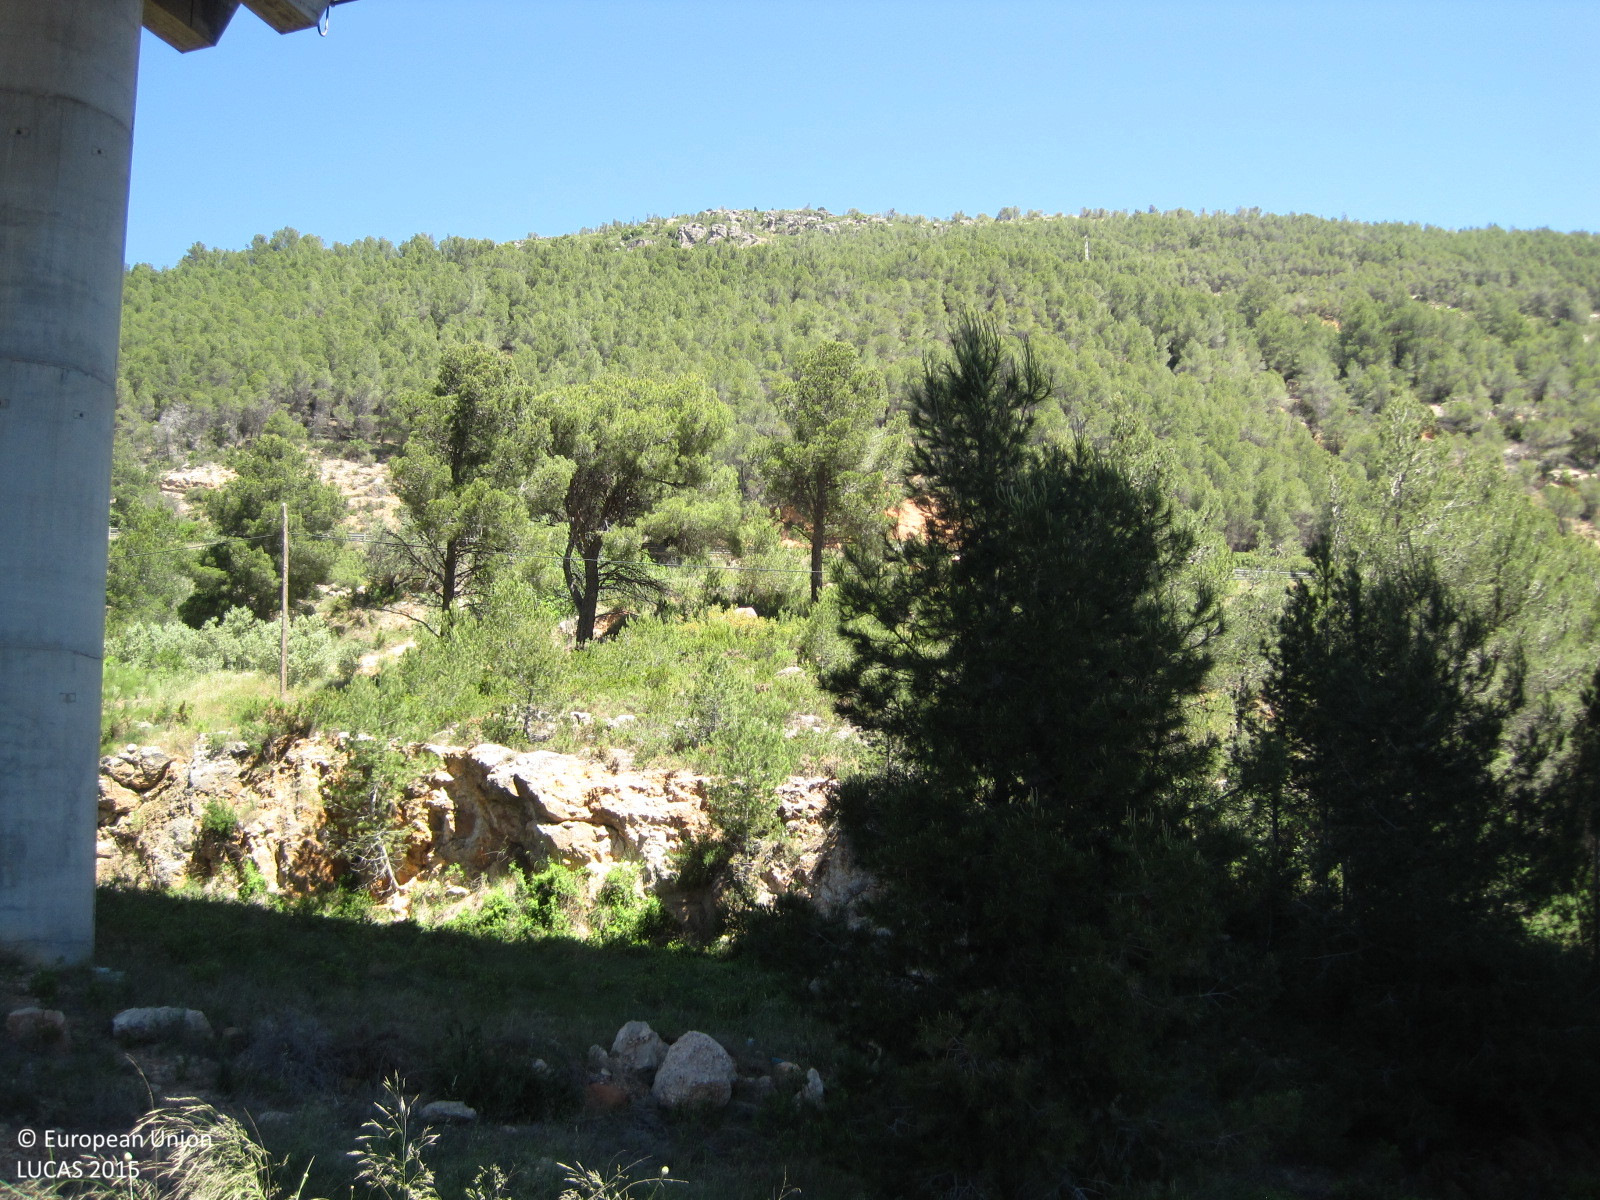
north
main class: Artificial land
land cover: Non built-up linear features
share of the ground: > 75 %
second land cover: Grassland without tree/shrub cover
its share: > 75 %
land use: Road transport
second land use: Forestry
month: May
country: ES
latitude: 39.4305
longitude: -0.8148
